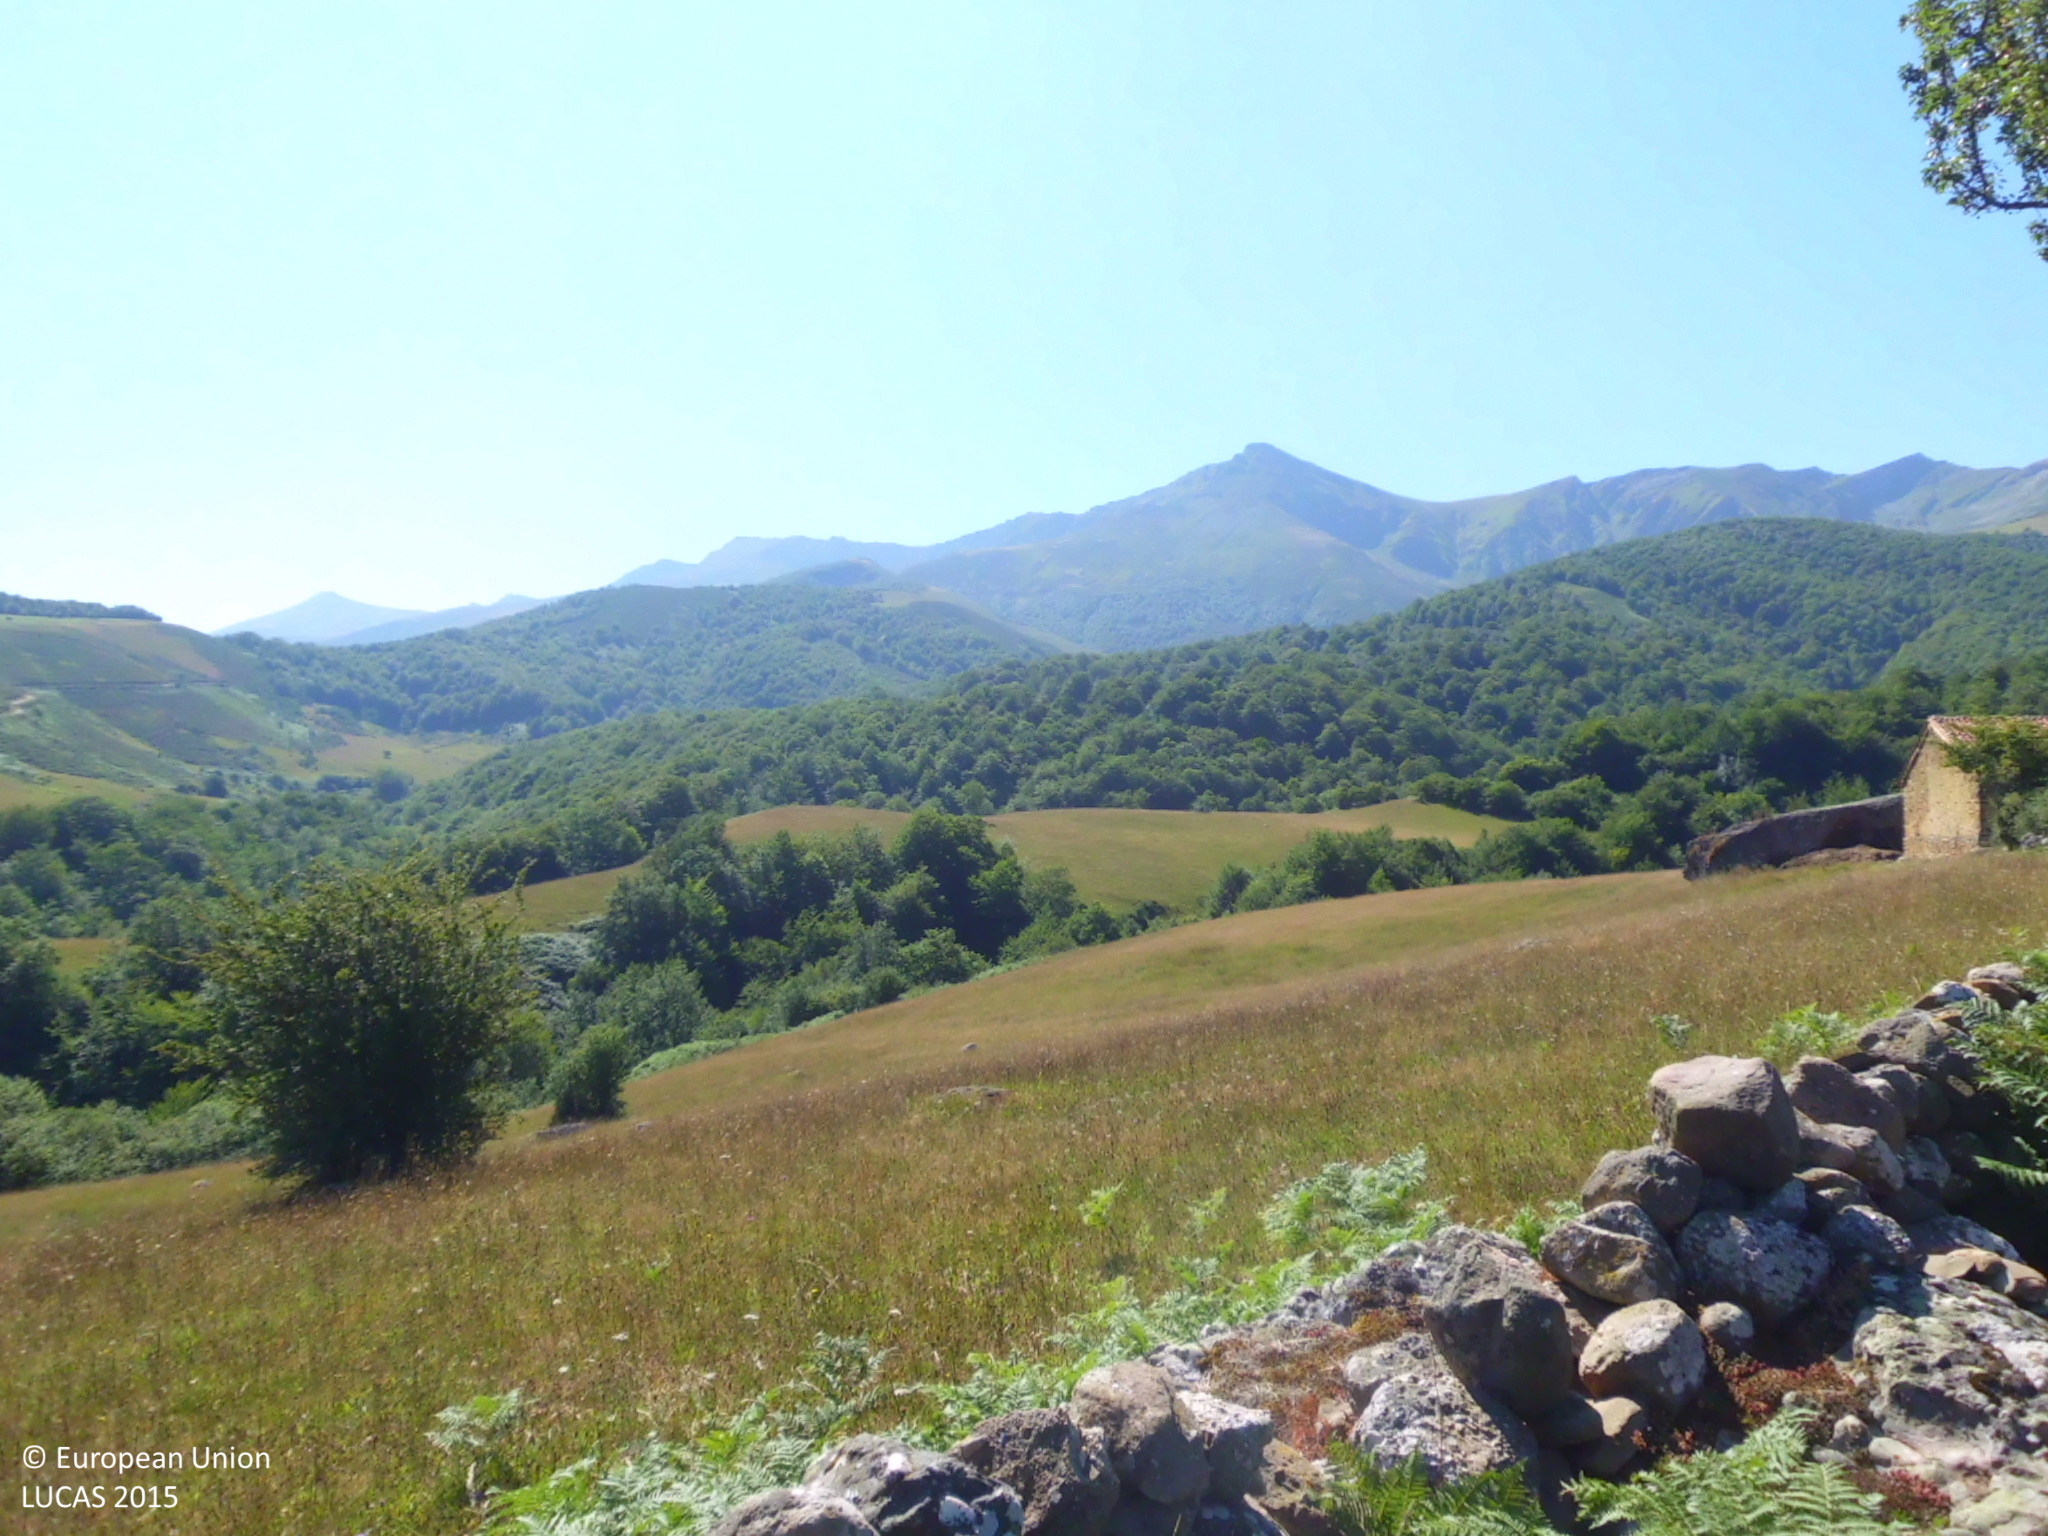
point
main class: Woodland
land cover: Broadleaved woodland
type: broadleaved evergreen forest
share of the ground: > 75 %
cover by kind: broadleaved forest trees 100 %
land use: Semi-natural and natural areas not in use
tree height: > 5 m
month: July
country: ES
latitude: 43.0640
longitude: -4.4103
